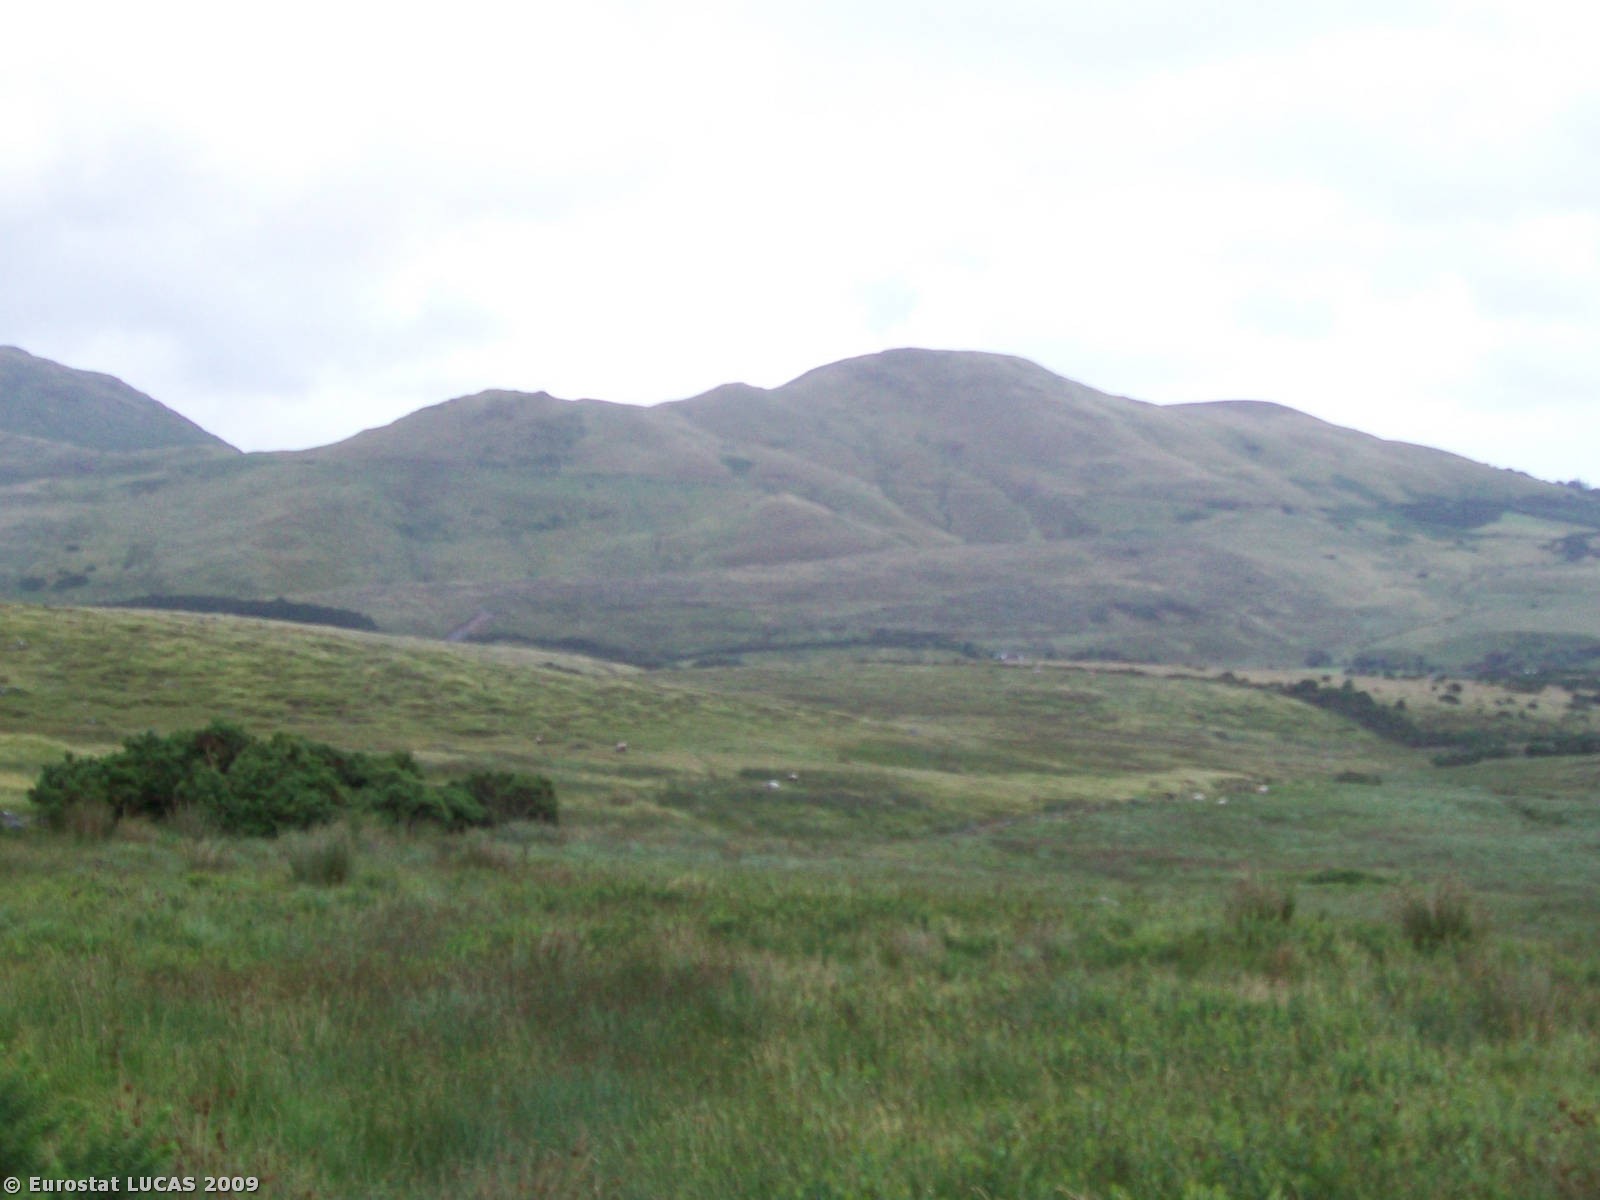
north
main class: Grassland
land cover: Grassland without tree/shrub cover
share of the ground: > 75 %
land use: Agriculture (excluding fallow land and kitchen gardens)
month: July
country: IE
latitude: 53.6094
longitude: -9.5034
